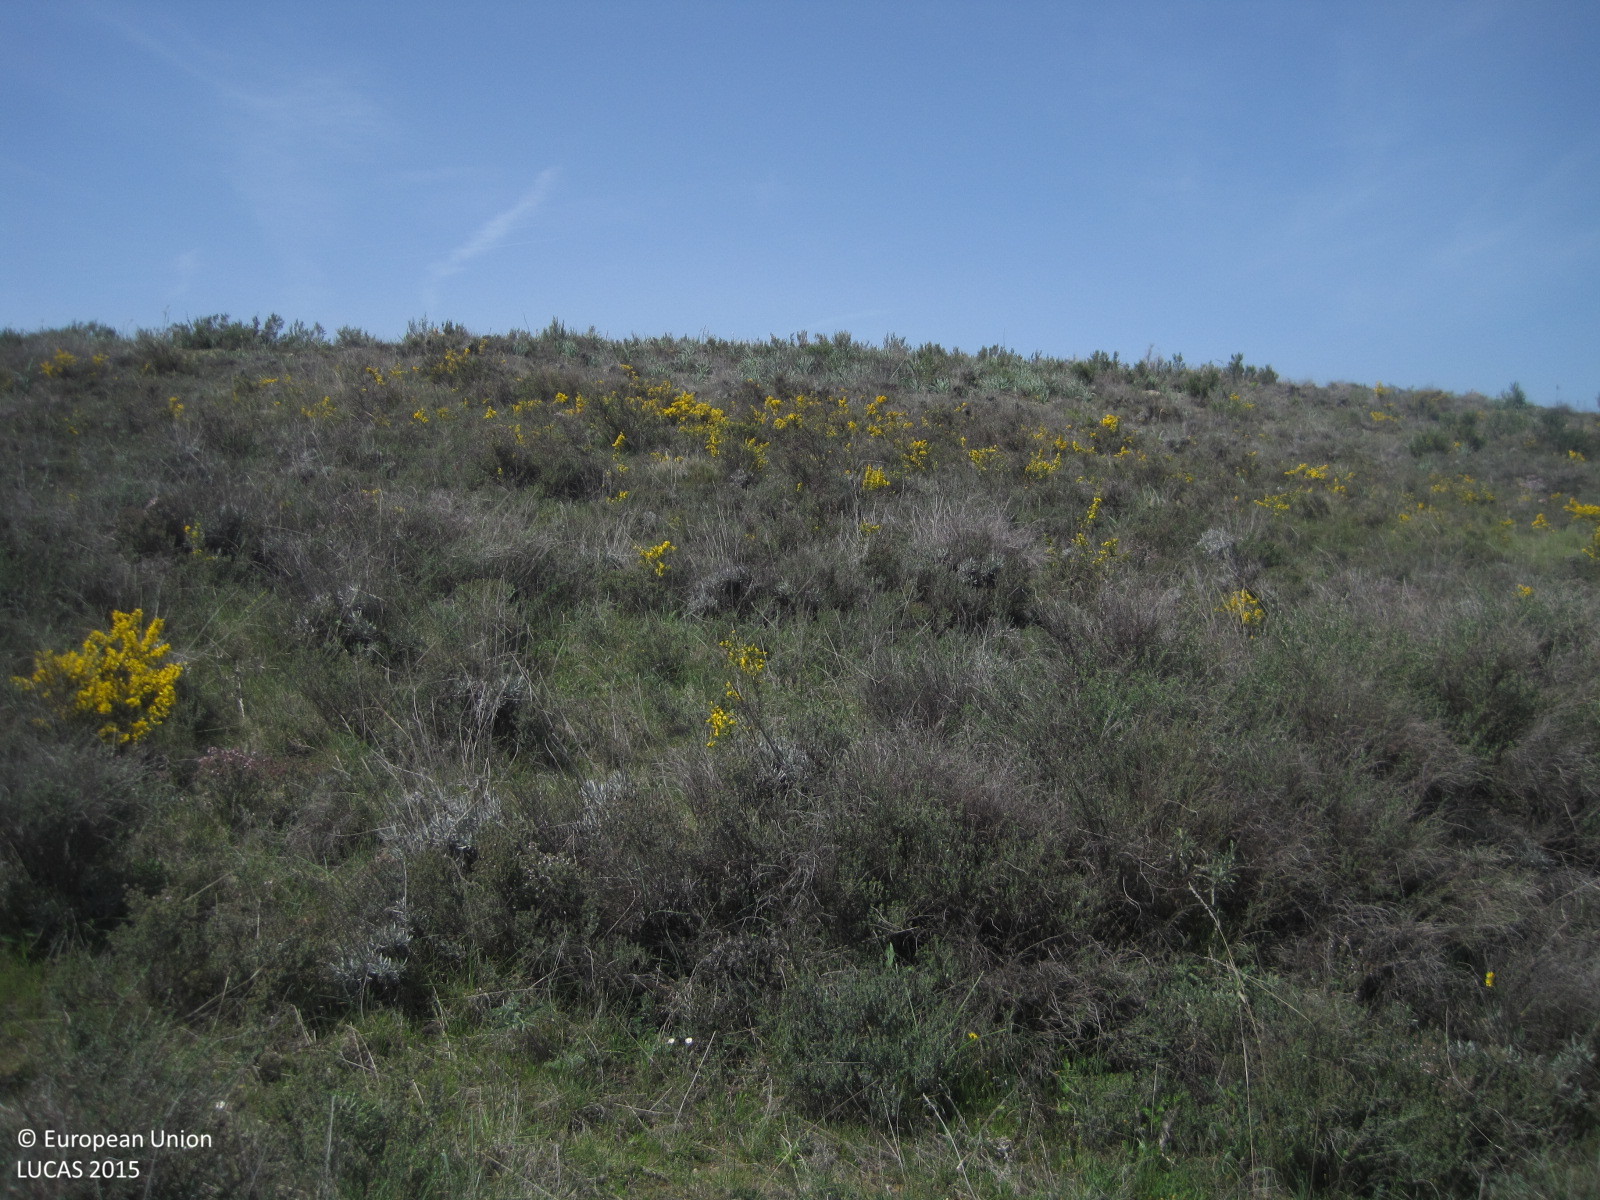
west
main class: Shrubland
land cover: Shrubland without tree cover
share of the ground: > 75 %
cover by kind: shrubs 60 %, herbaceous plants 40 %
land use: Semi-natural and natural areas not in use
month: April
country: ES
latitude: 42.5244
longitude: -2.2775
